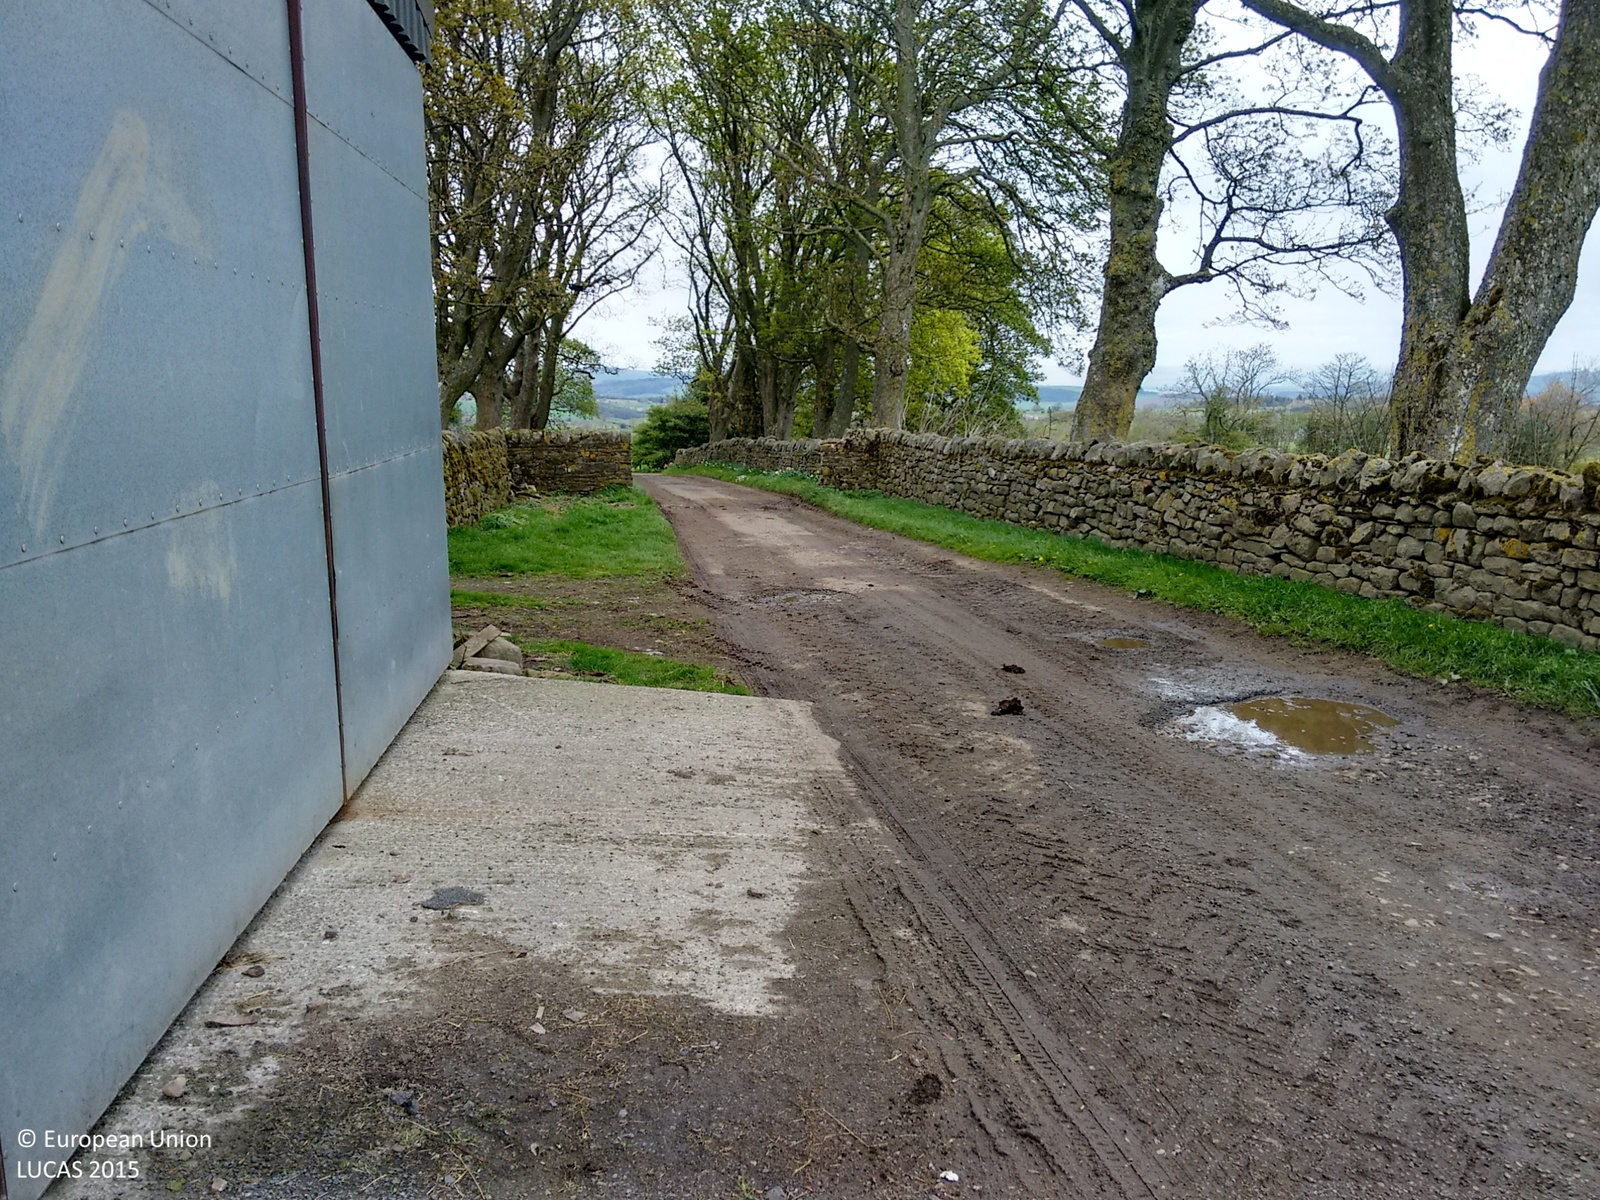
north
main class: Grassland
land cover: Grassland without tree/shrub cover
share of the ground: > 75 %
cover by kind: herbaceous plants 100 %
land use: Agriculture (excluding fallow land and kitchen gardens)
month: May
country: GB
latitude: 54.9517
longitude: -2.1582
